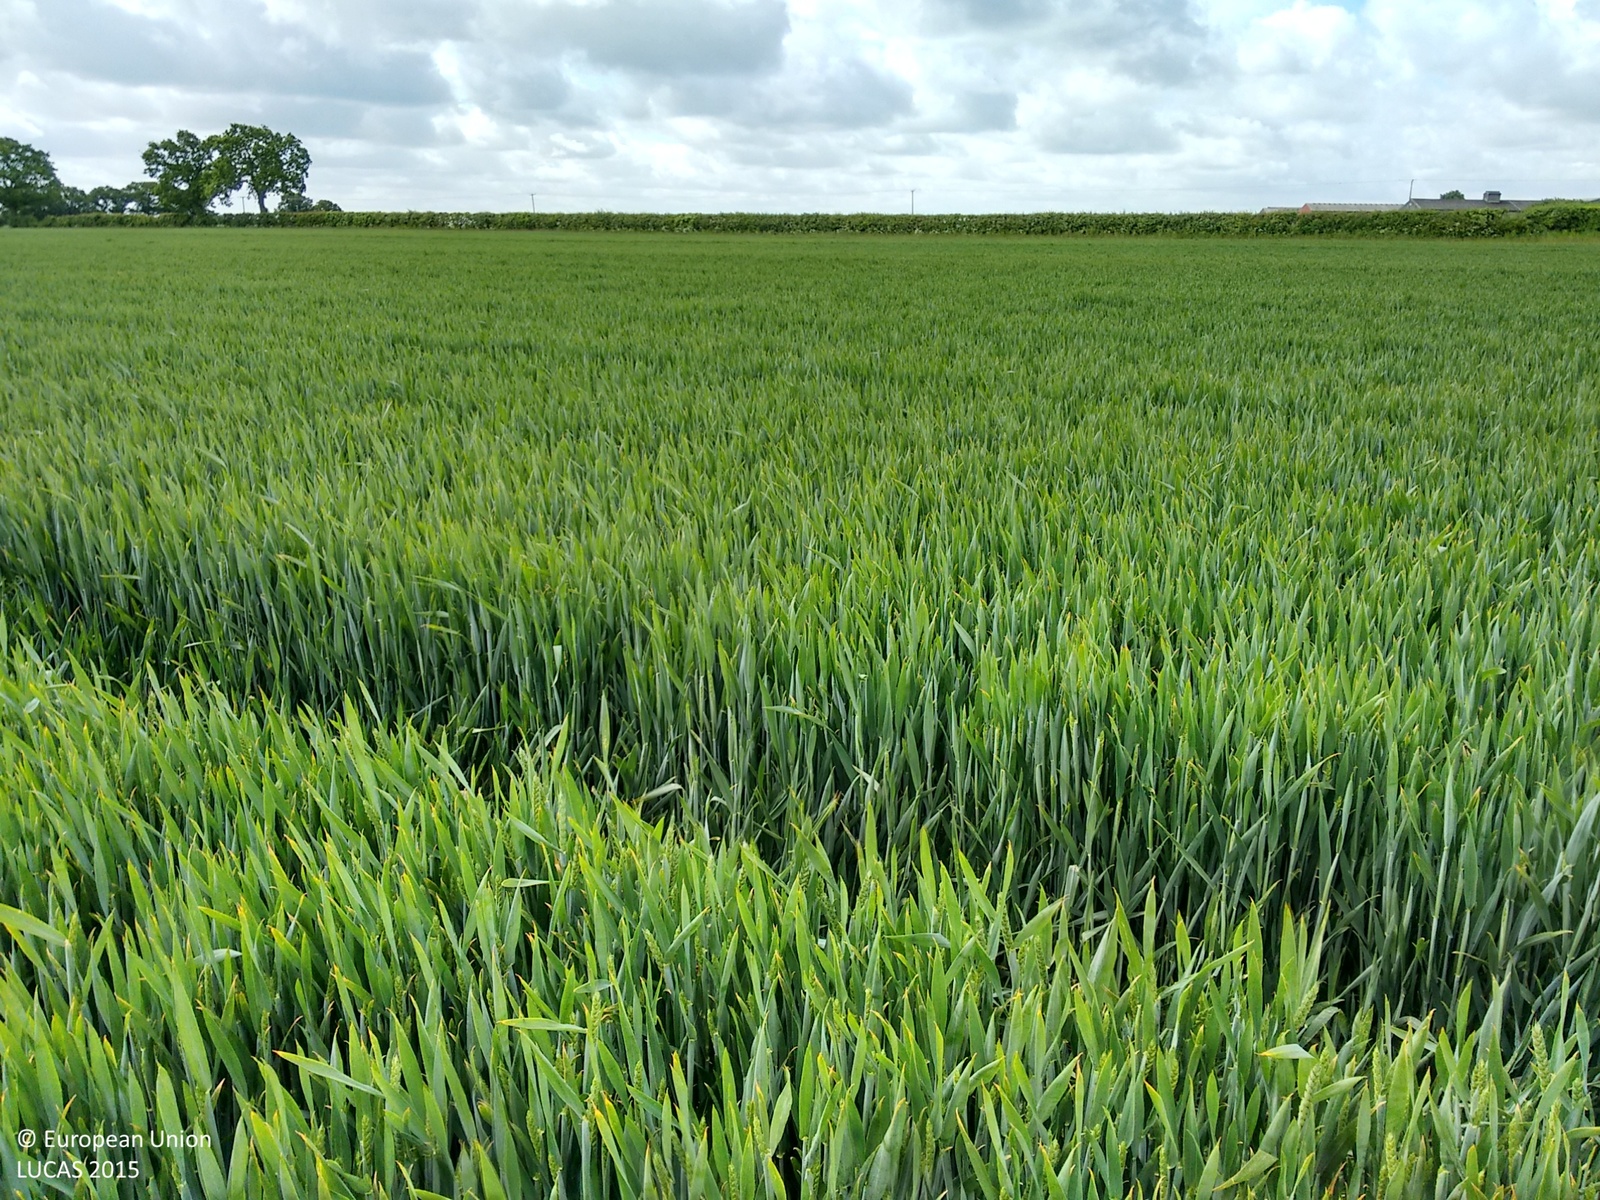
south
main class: Cropland
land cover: Common wheat
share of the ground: > 75 %
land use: Agriculture (excluding fallow land and kitchen gardens)
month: June
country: GB
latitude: 52.2135
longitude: -0.3547
